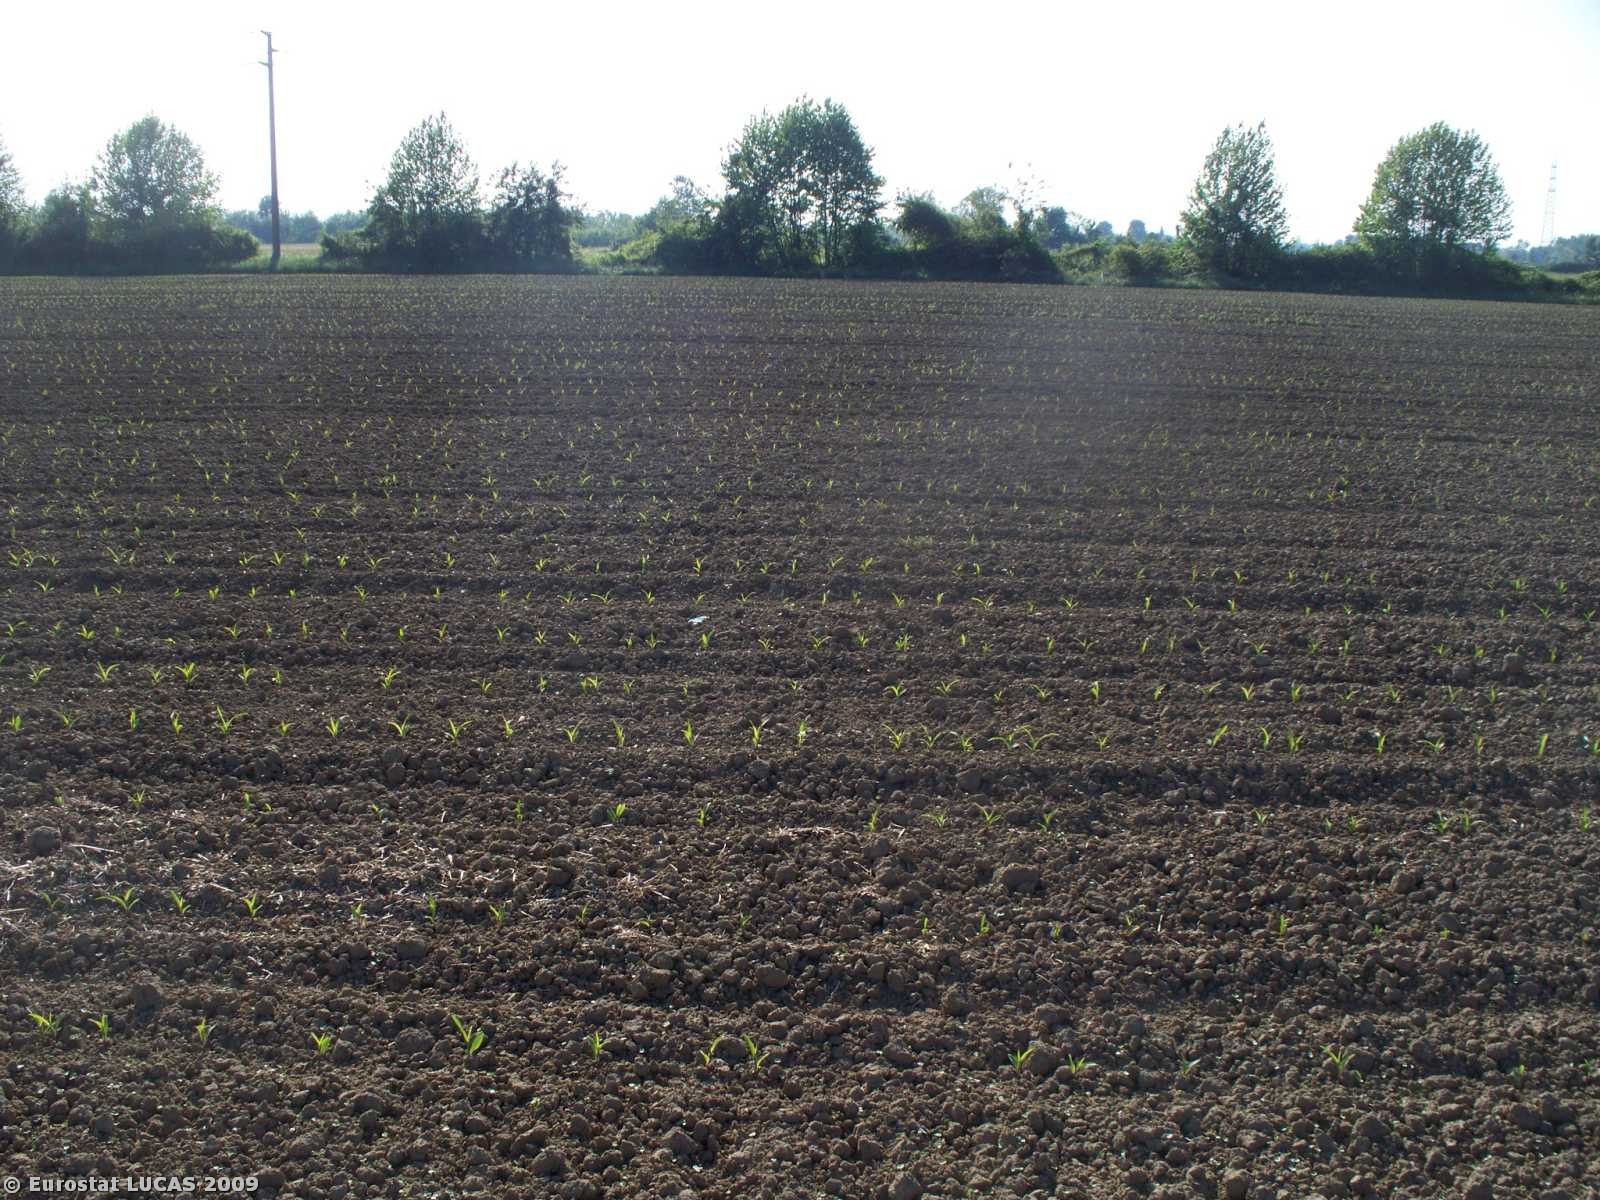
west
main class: Cropland
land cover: Maize
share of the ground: < 10 %
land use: Agriculture (excluding fallow land and kitchen gardens)
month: May
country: IT
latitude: 45.5199
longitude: 12.0835
